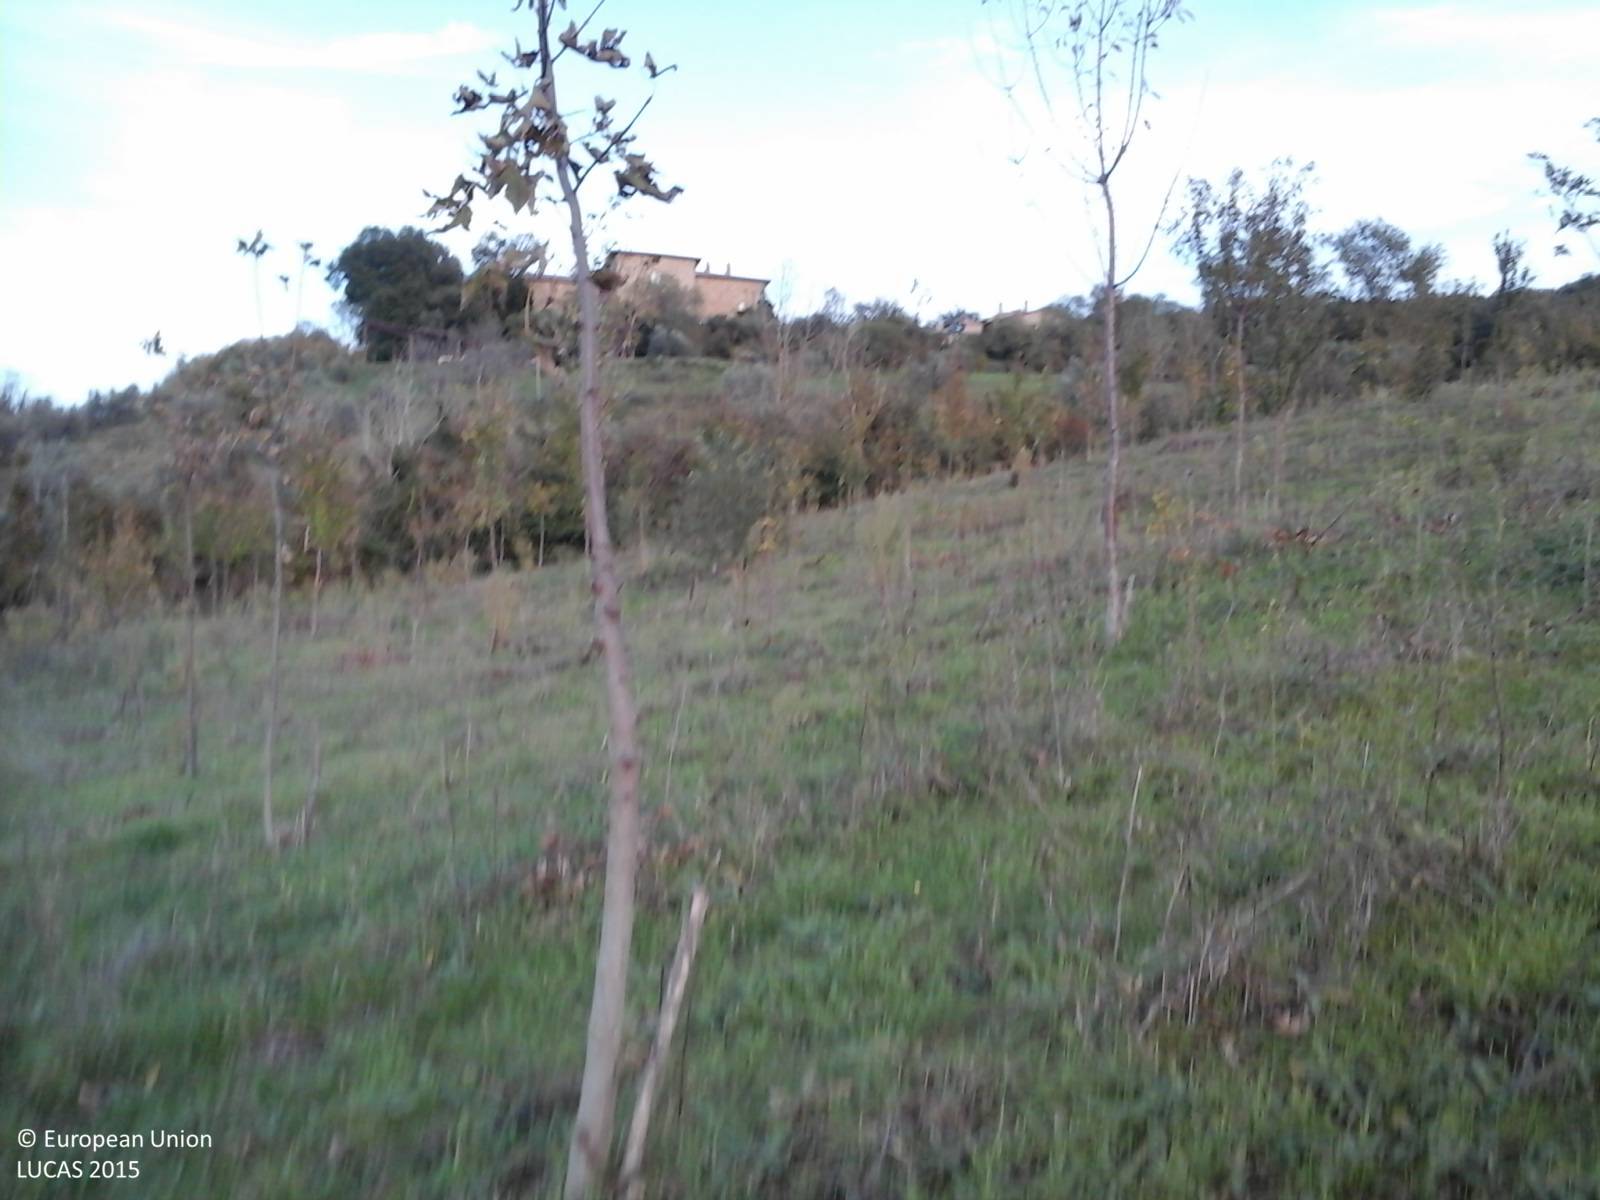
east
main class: Cropland
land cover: Cherry fruit
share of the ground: 50 - 75 %
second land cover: Spontaneously vegetated surfaces
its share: > 75 %
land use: Agriculture (excluding fallow land and kitchen gardens)
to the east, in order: Cherry fruit; Spontaneously vegetated surfaces; Broadleaved woodland; Abandoned hedges; Ditches and canals; Abandoned hedges; Fences; Grassland with sparse tree/shrub cover; Ditches and canals; Other fresh vegetables; Grassland with sparse tree/shrub cover; Artificial constructions in urban areas; Conifer hedges; Grassland with sparse tree/shrub cover; Dry stone walls; Paved roads, cycling and walking lanes; Grassland without tree/shrub cover; Electric lines; Ditches and canals; Grassland without tree/shrub cover
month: October
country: IT
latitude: 42.8085
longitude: 12.3041
